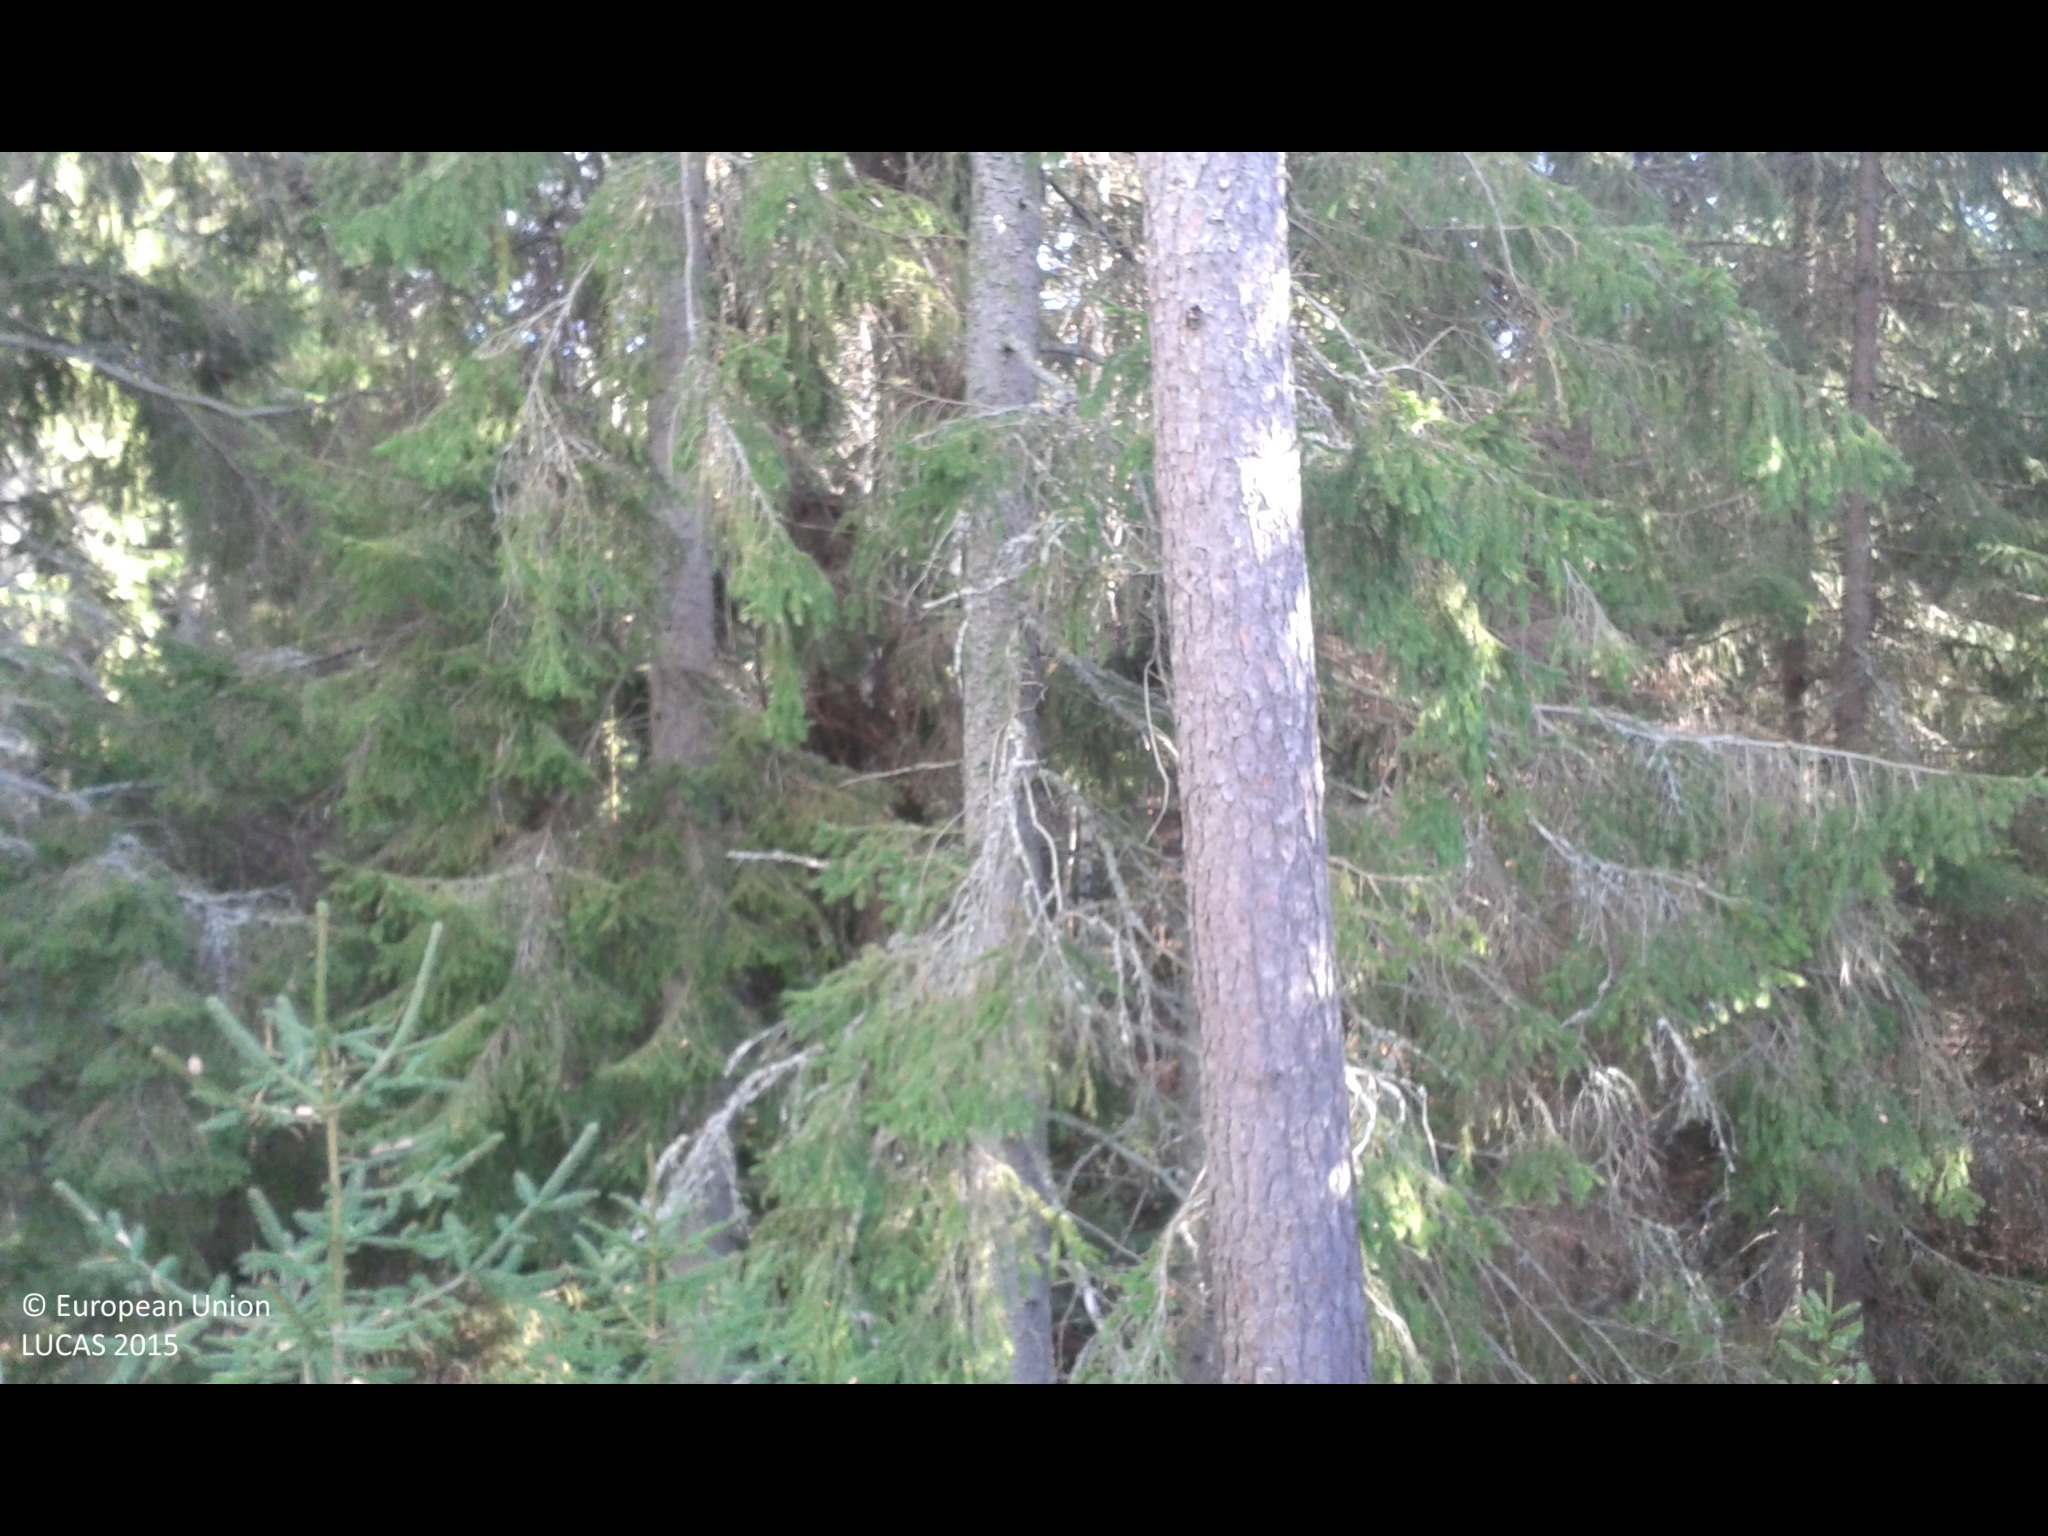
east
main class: Woodland
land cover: Other coniferous woodland
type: boreal forest
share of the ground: 25 - 50 %
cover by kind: herbaceous plants 40 %, coniferous forest trees 35 %, lichens and mosses 20 %, broadleaved forest trees 5 %
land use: Forestry
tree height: > 5 m
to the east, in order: Other coniferous woodland; Spruce dominated coniferous woodland; Pine dominated coniferous woodland
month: October
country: SE
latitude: 58.7990
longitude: 17.2836
